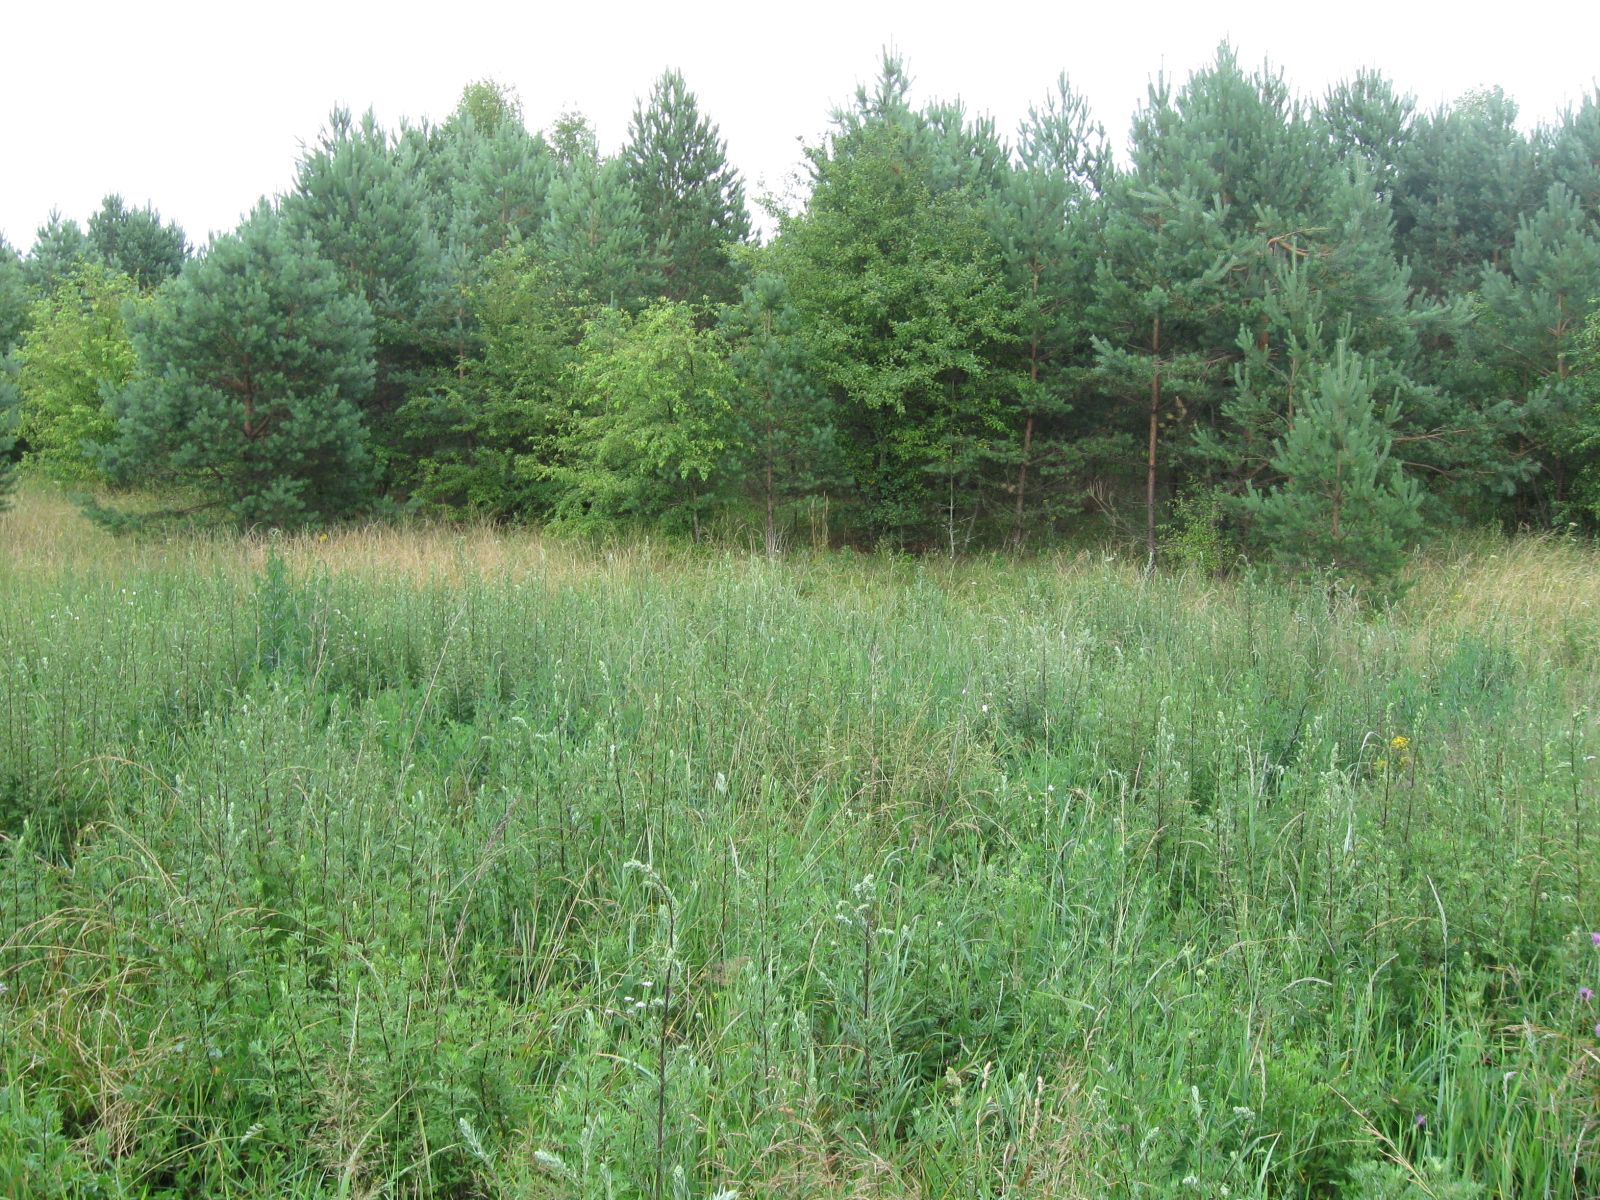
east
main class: Grassland
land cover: Grassland with sparse tree/shrub cover
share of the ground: > 75 %
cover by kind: herbaceous plants 90 %, broadleaved forest trees 5 %, shrubs 5 %
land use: Forestry
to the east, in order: Grassland with sparse tree/shrub cover; Pine dominated mixed woodland; Paved roads, cycling and walking lanes; Pine dominated mixed woodland; Electric lines; Pine dominated mixed woodland
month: July
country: LT
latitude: 54.0320
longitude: 23.6275
